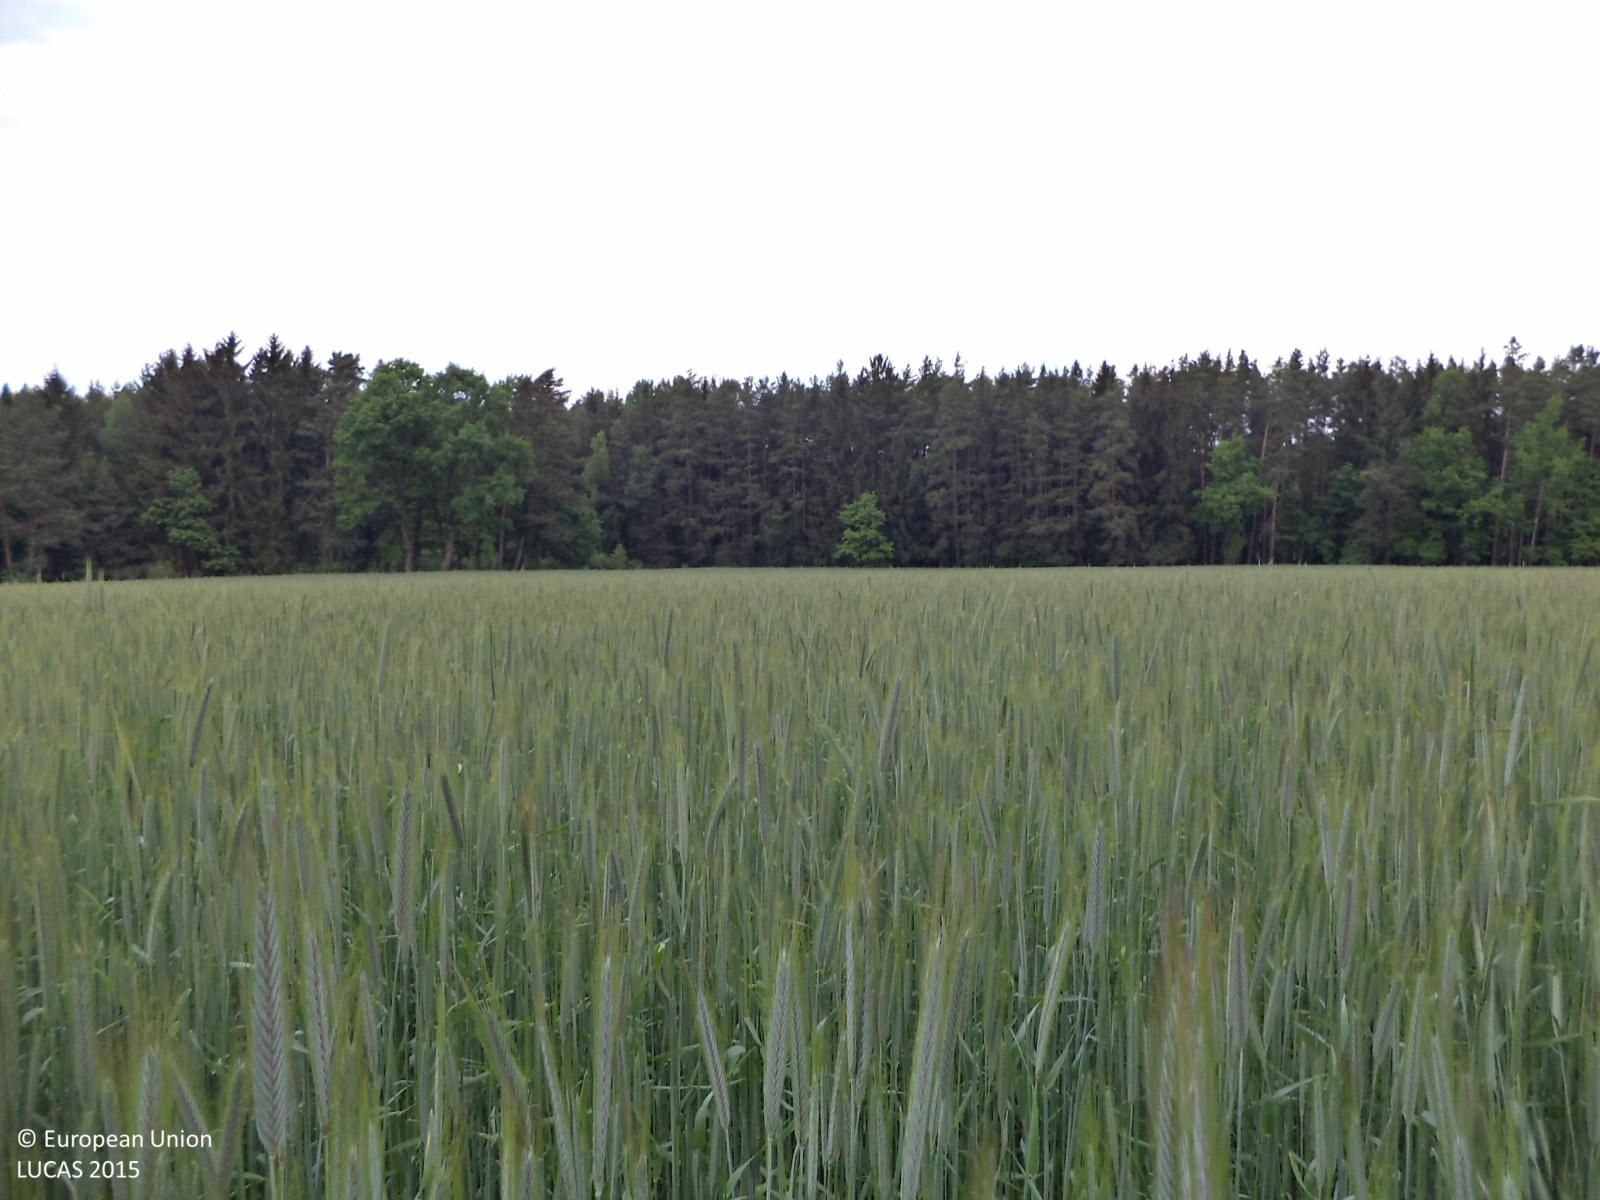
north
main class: Cropland
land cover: Rye
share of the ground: > 75 %
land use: Agriculture (excluding fallow land and kitchen gardens)
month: May
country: CZ
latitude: 49.2019
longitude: 14.7642
